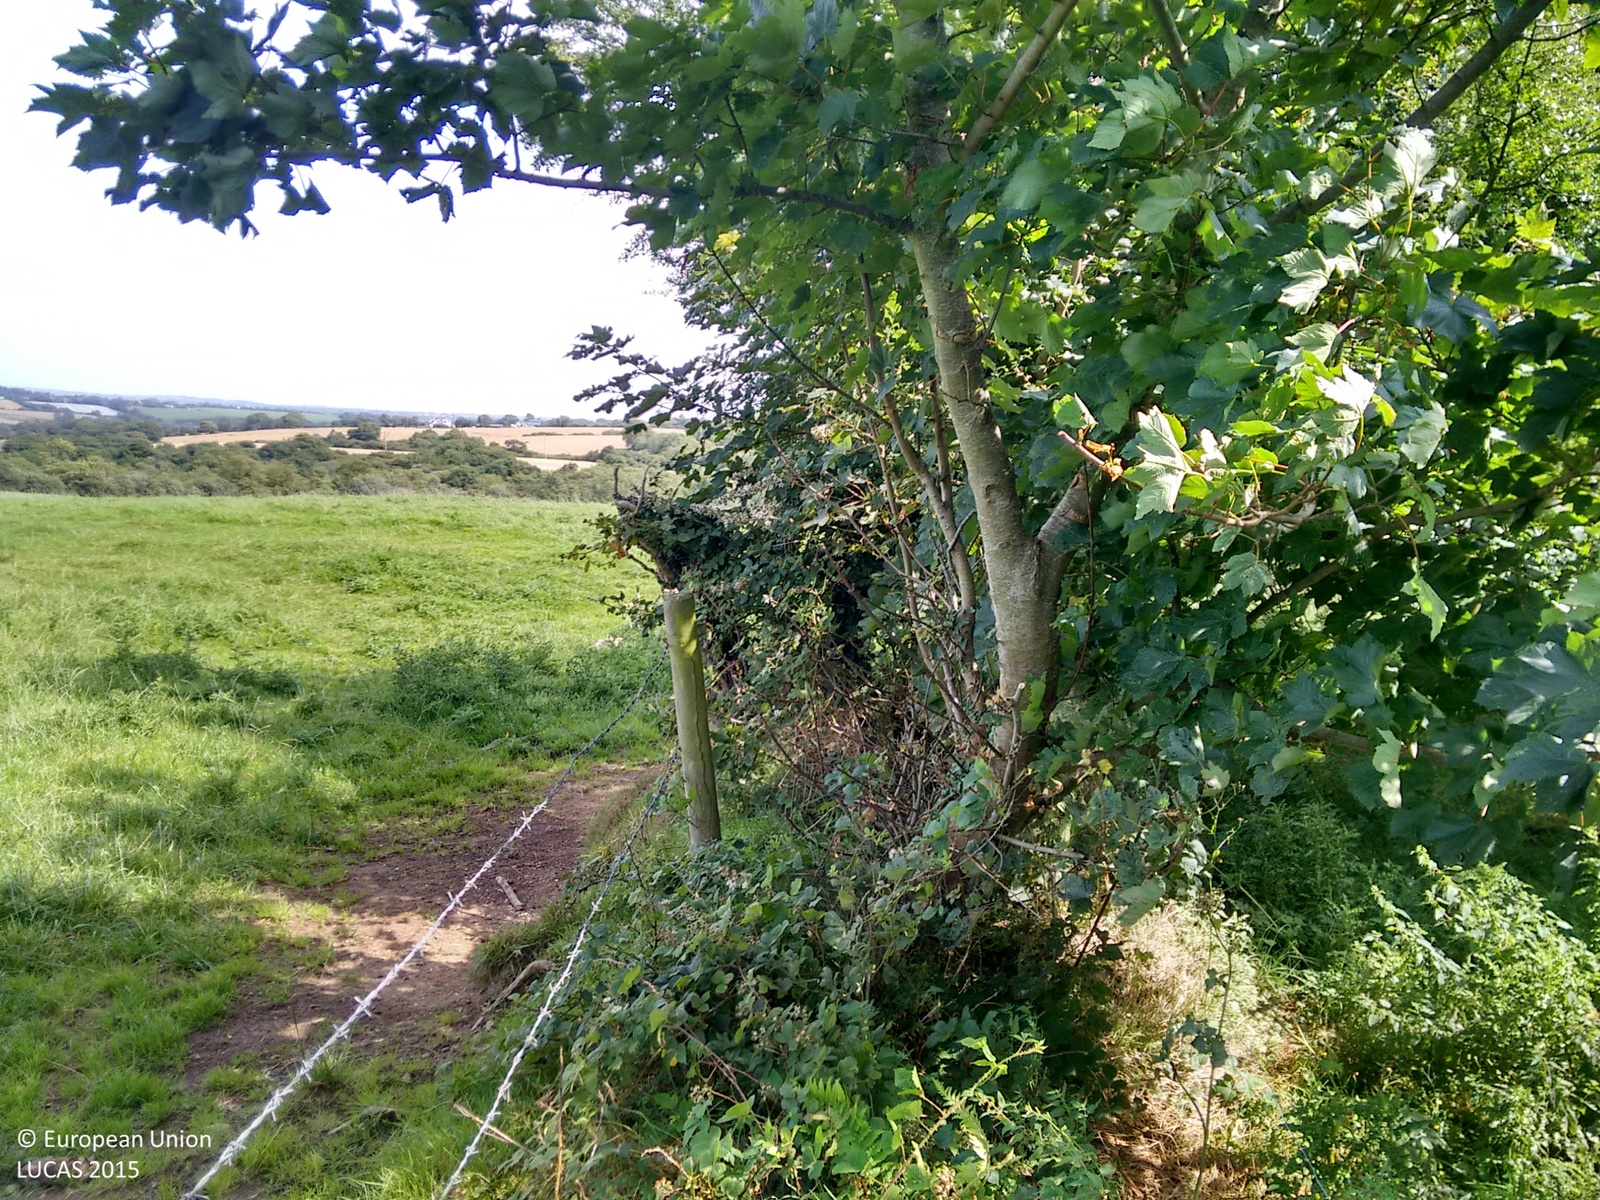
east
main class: Grassland
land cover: Grassland without tree/shrub cover
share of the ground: > 75 %
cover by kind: herbaceous plants 100 %
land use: Agriculture (excluding fallow land and kitchen gardens)
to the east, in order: Grassland without tree/shrub cover; Broadleaved woodland
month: August
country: IE
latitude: 52.3426
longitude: -6.5546
